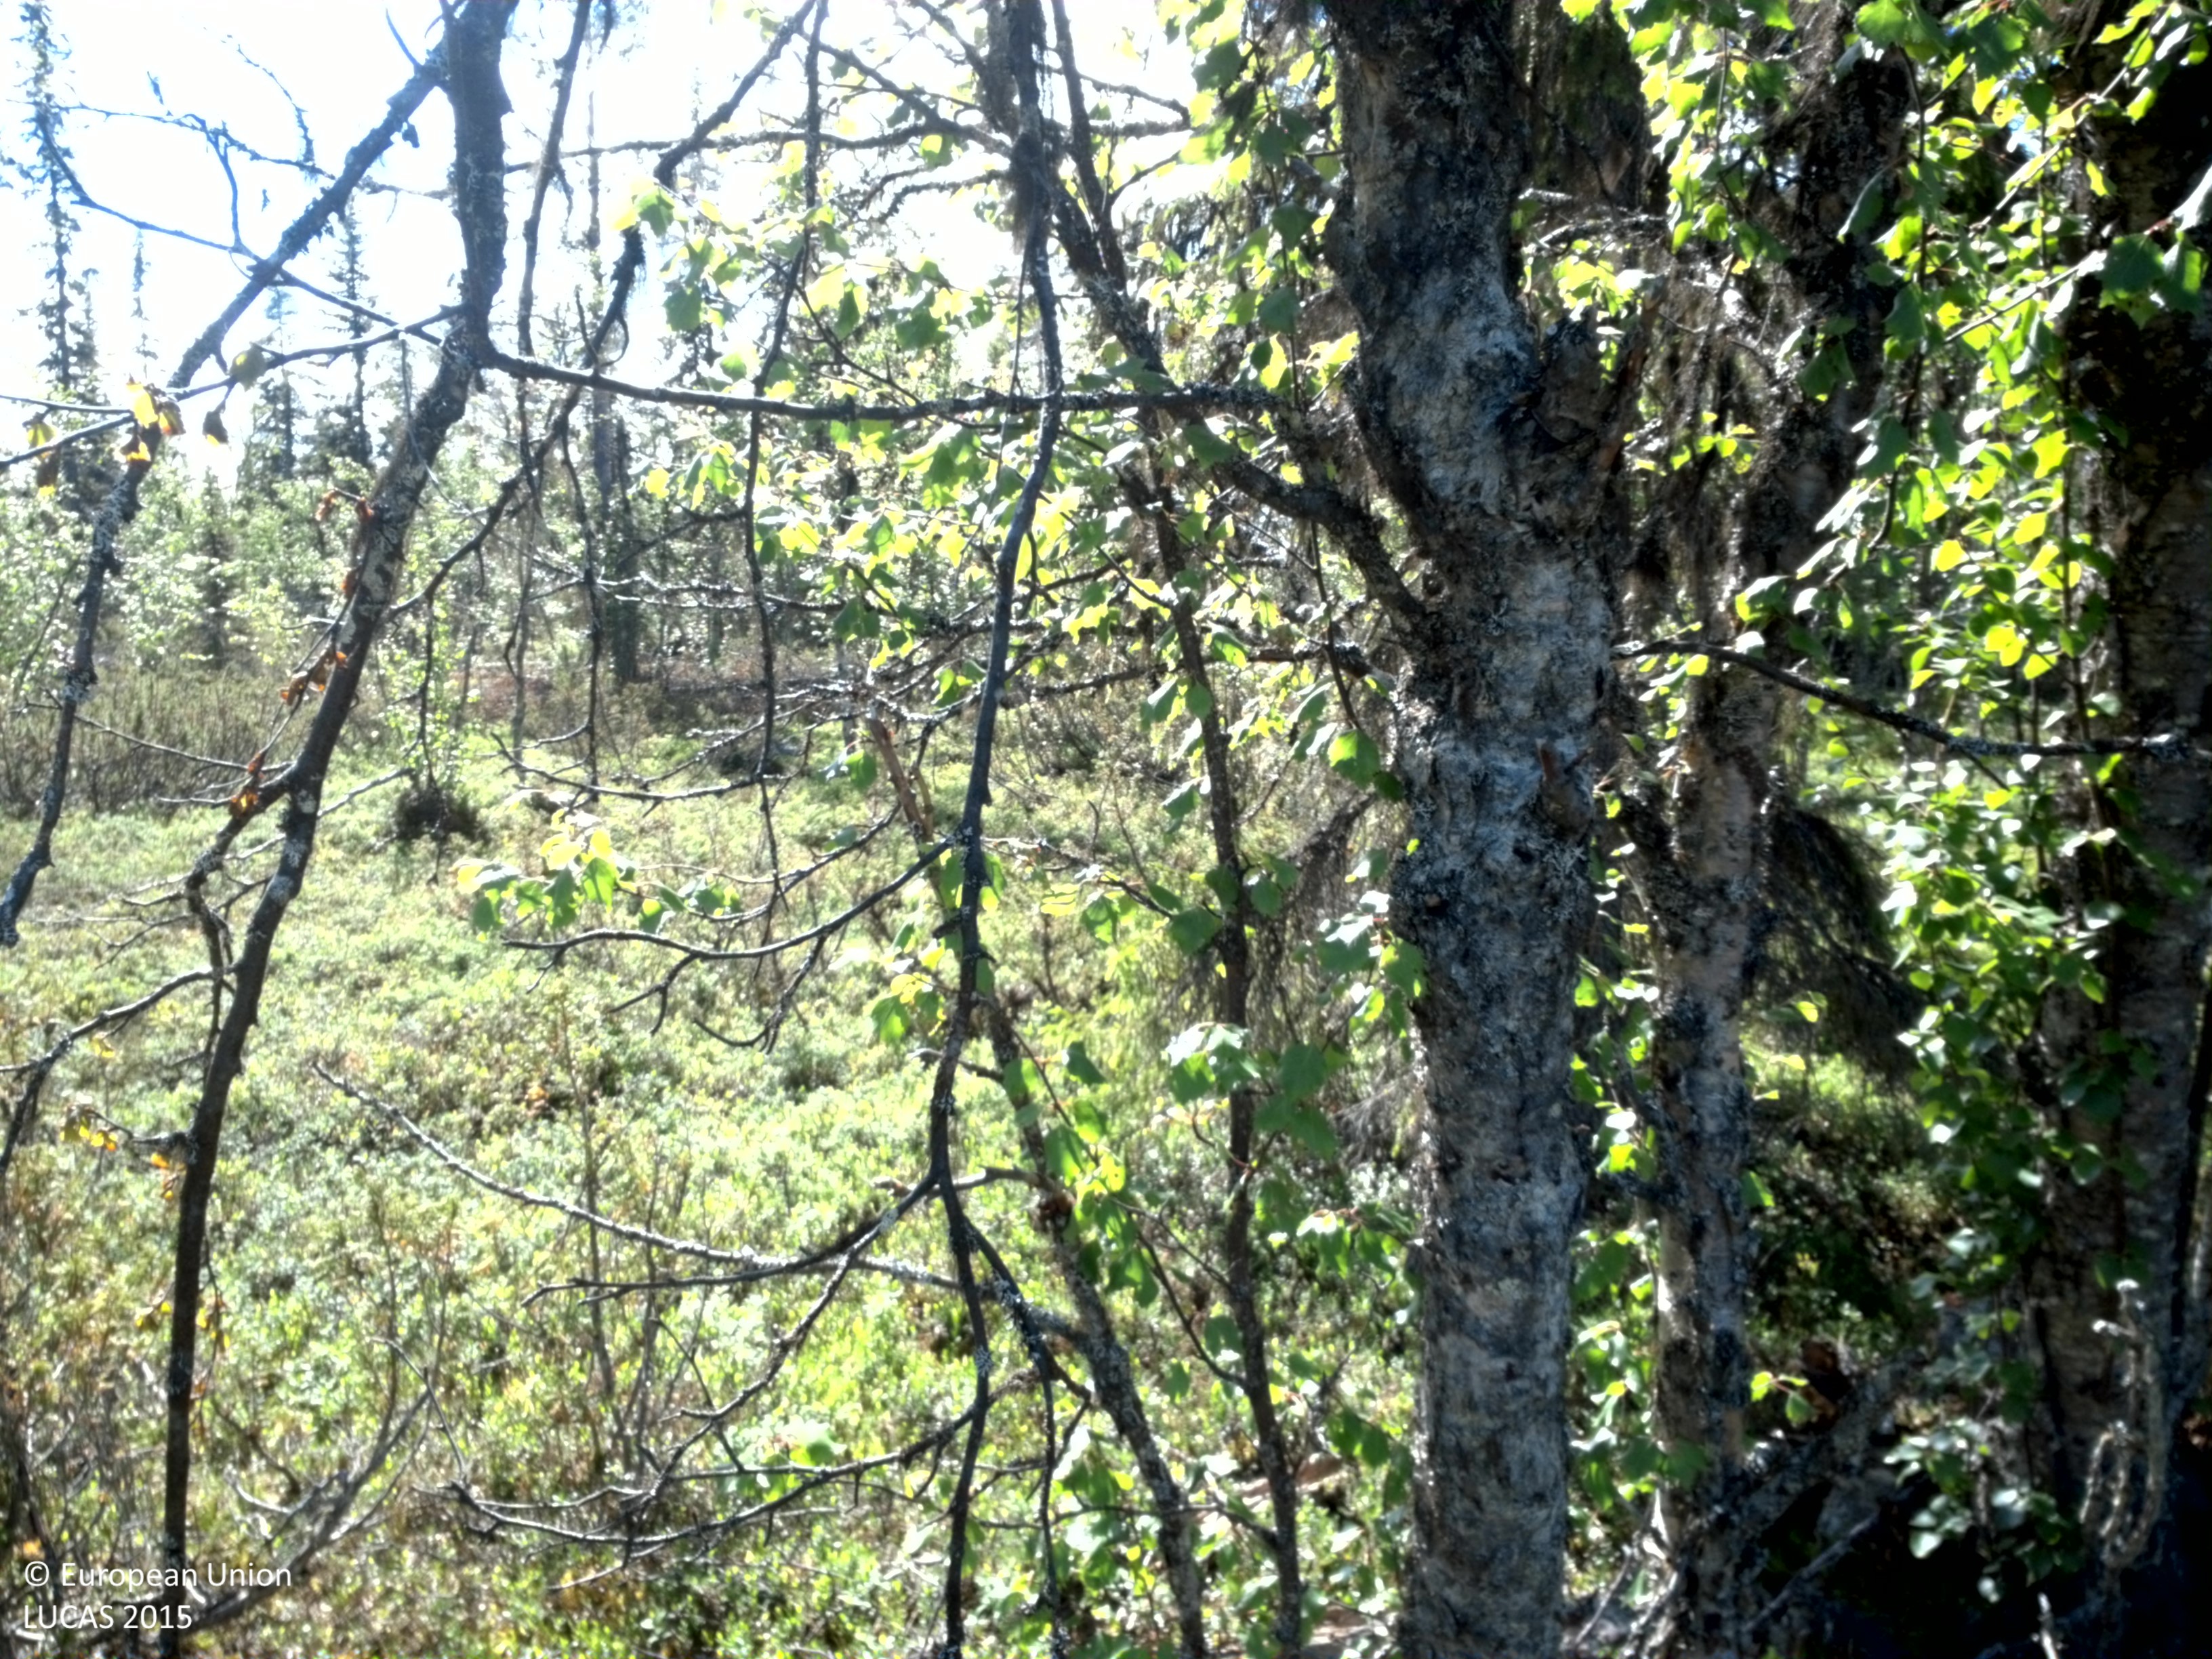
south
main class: Woodland
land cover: Spruce dominated mixed woodland
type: boreal forest
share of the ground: 10 - 25 %
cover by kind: shrubs 70 %, lichens and mosses 15 %, coniferous forest trees 10 %, broadleaved forest trees 5 %
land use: Forestry
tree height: > 5 m
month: August
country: SE
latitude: 64.8949
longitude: 16.1554
